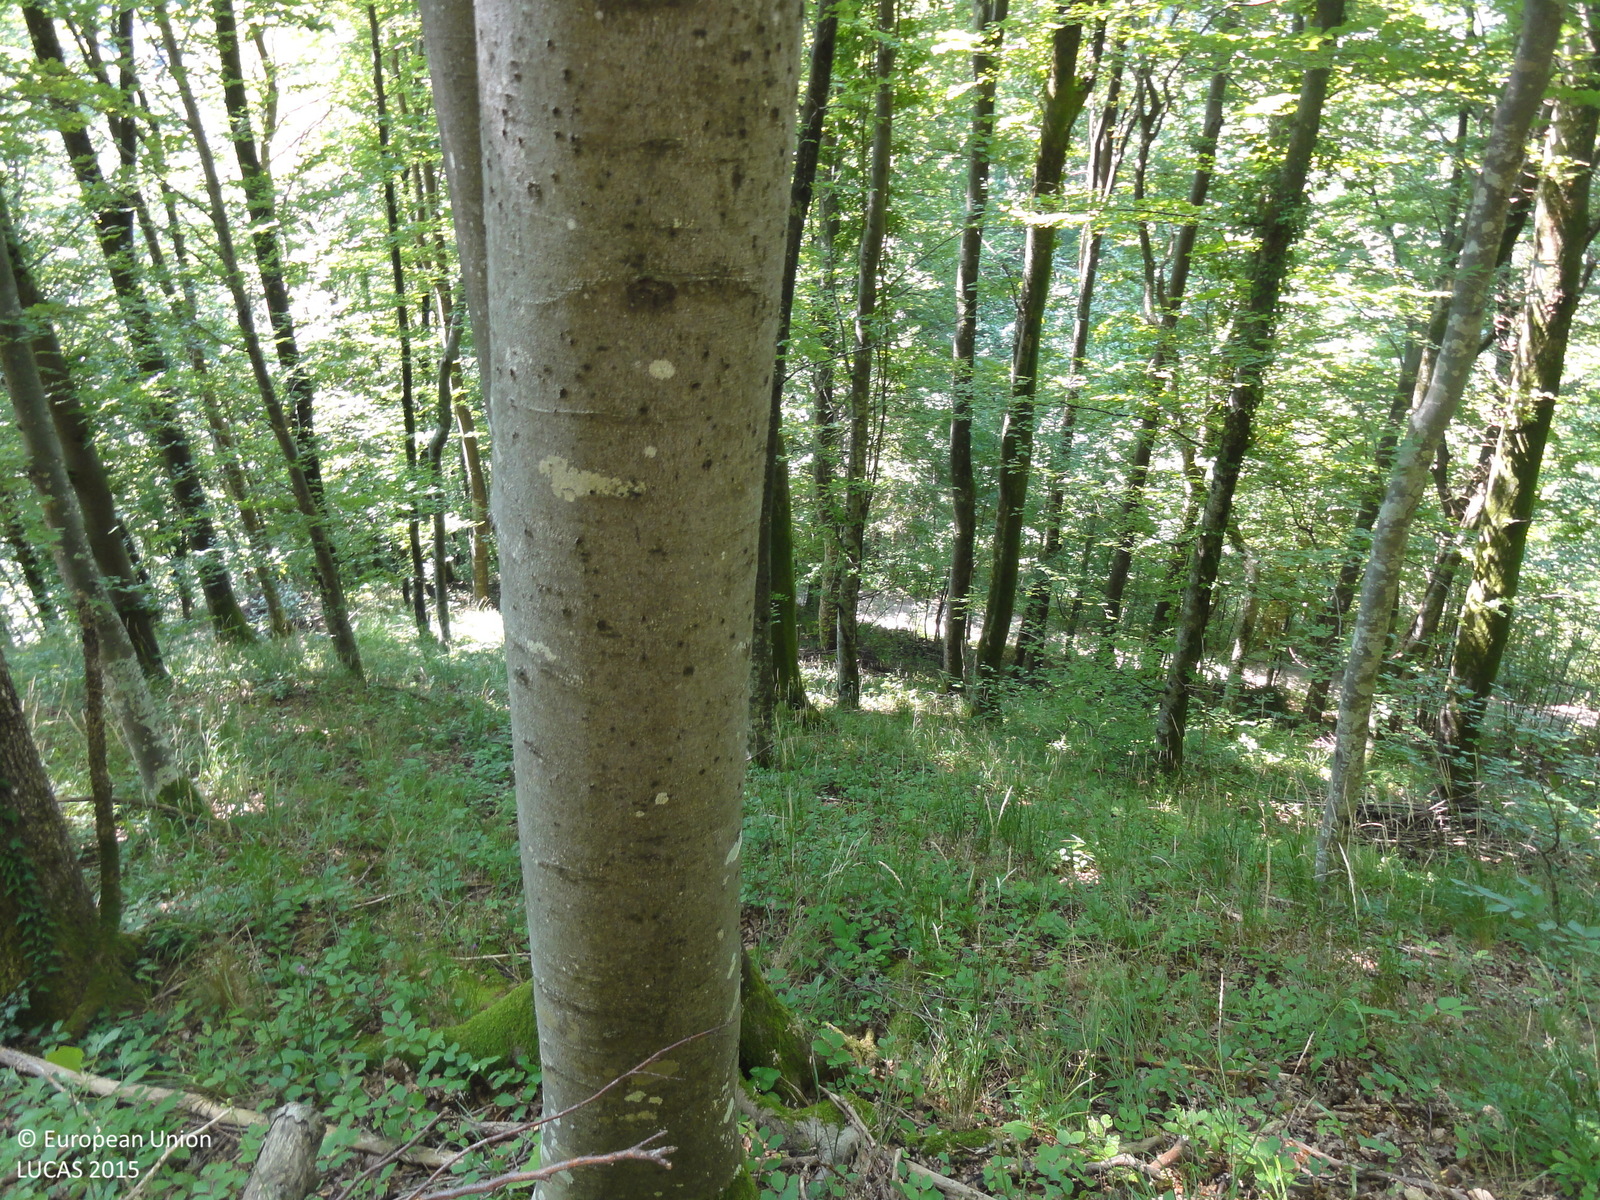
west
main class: Woodland
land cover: Broadleaved woodland
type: beech forest
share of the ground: > 75 %
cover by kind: broadleaved forest trees 100 %
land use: Forestry
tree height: > 5 m
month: August
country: SI
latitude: 45.9796
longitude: 15.0437
